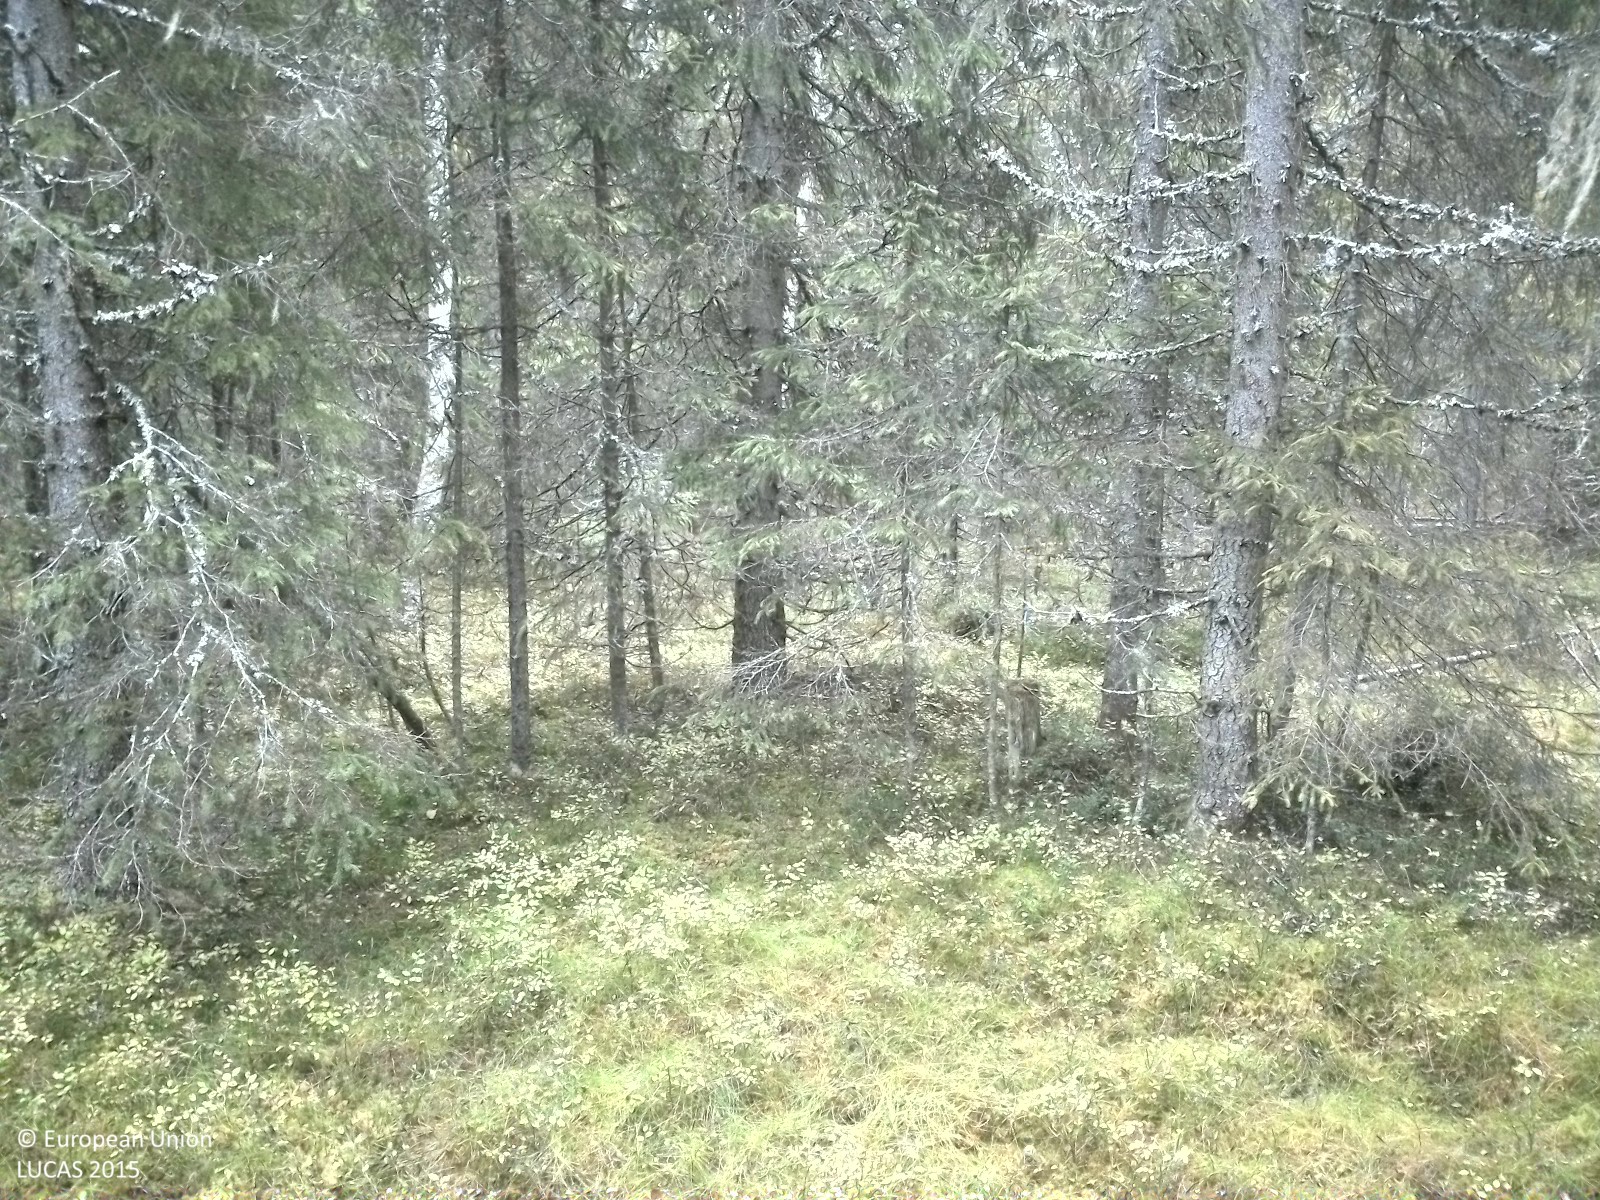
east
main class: Woodland
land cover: Spruce dominated coniferous woodland
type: boreal forest
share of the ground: > 75 %
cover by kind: coniferous forest trees 90 %, shrubs 10 %
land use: Forestry
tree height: > 5 m
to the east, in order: Spruce dominated coniferous woodland
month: October
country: SE
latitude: 63.5240
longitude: 14.9824
